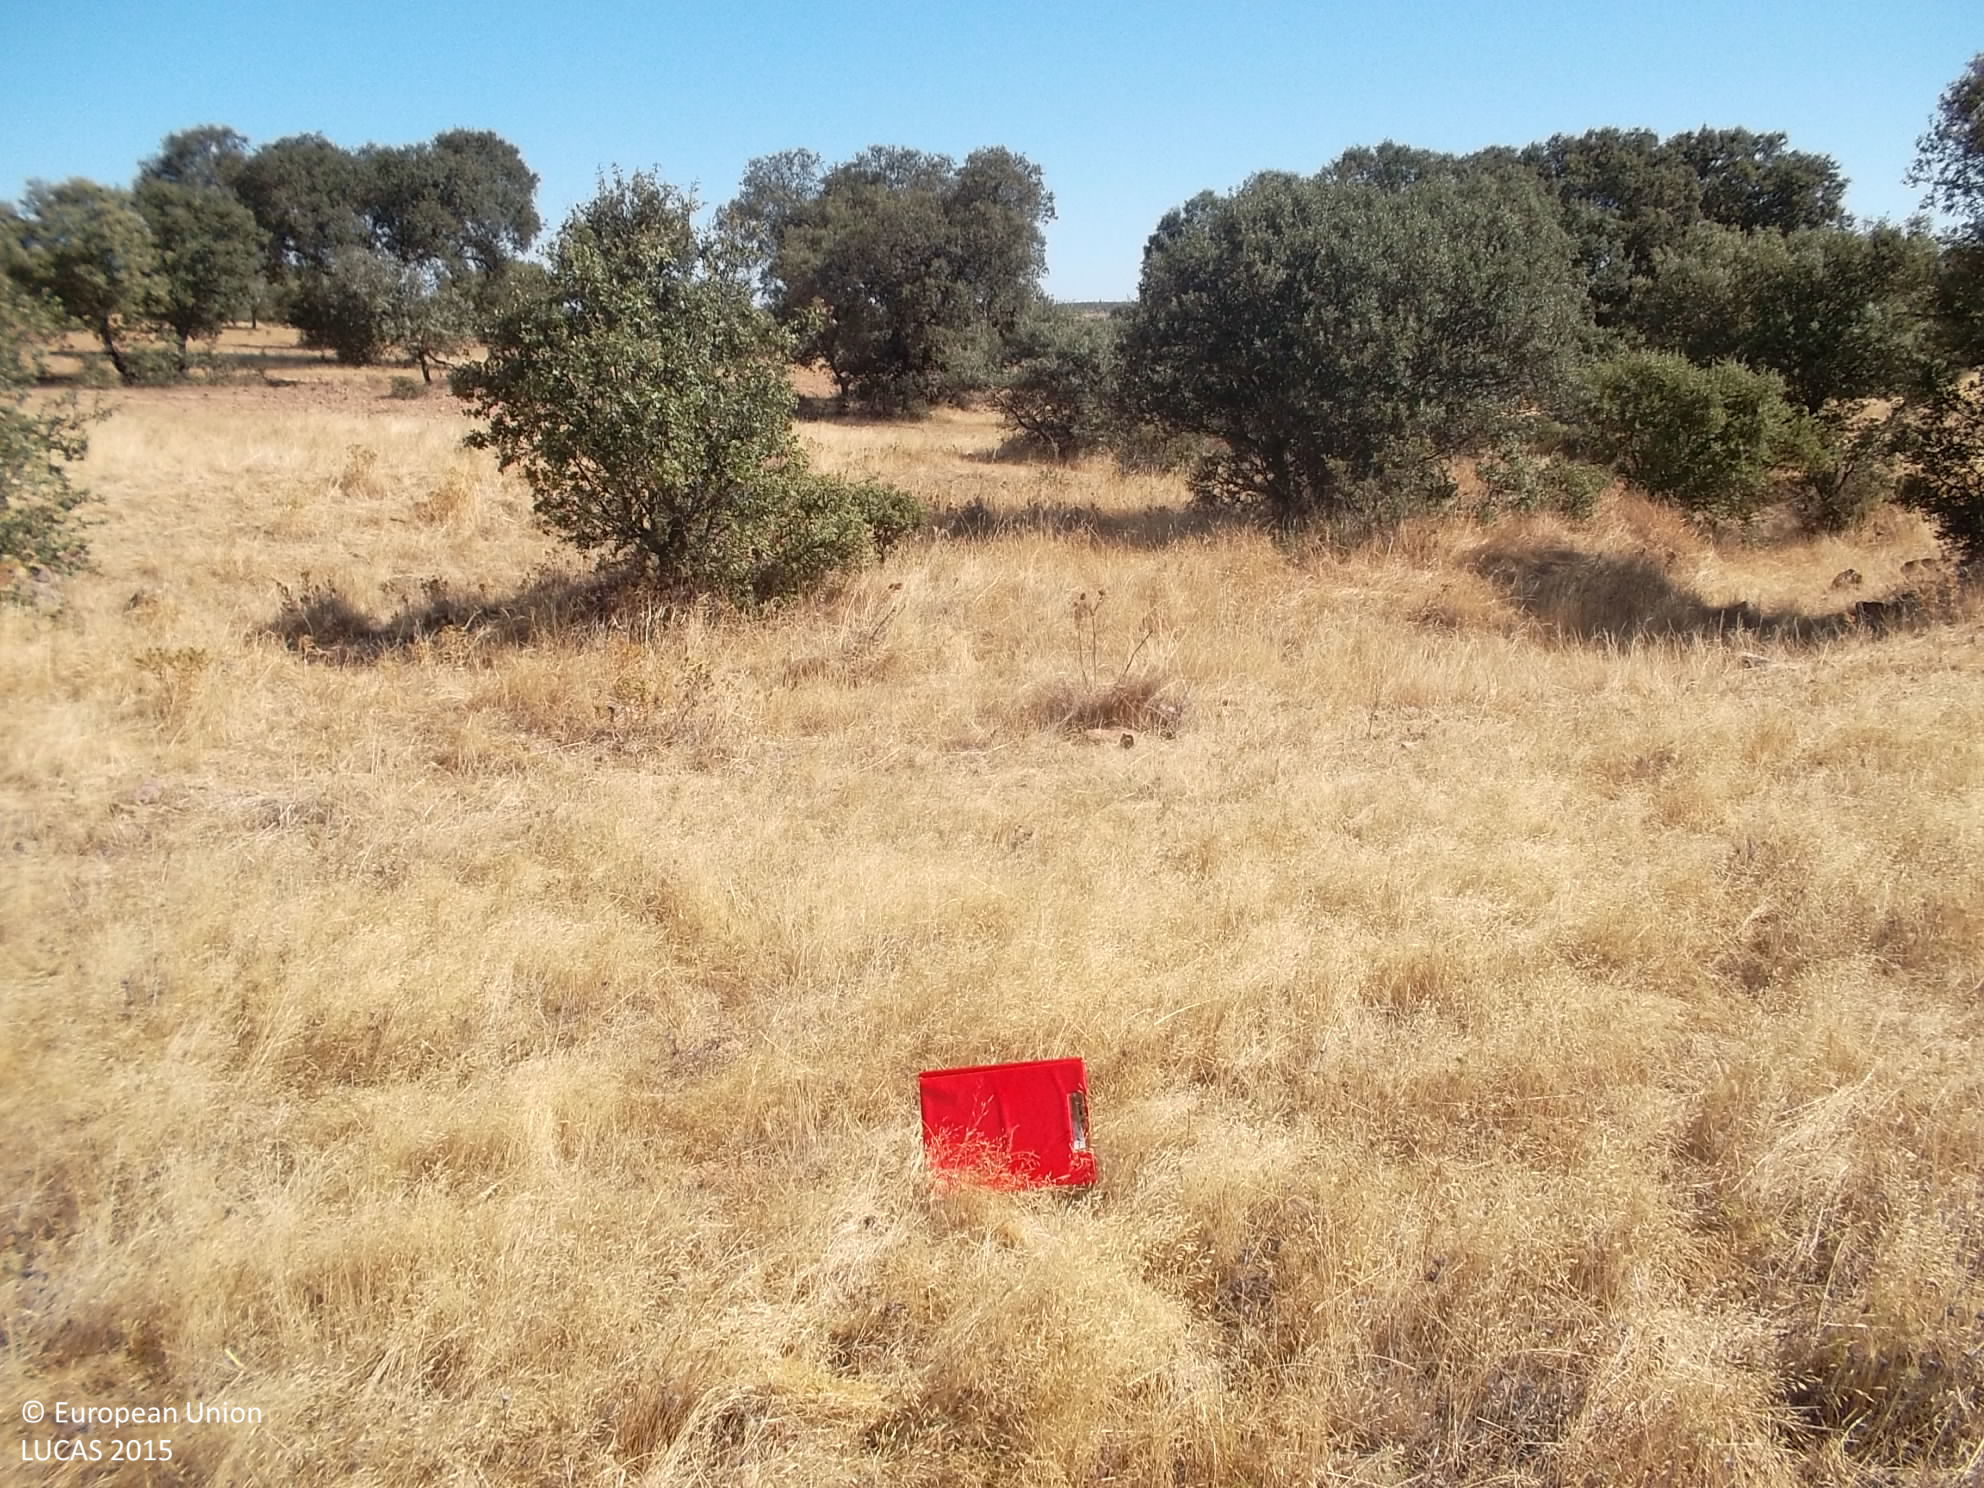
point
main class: Grassland
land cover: Grassland with sparse tree/shrub cover
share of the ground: > 75 %
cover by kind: herbaceous plants 90 %, broadleaved forest trees 5 %, shrubs 5 %
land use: Agriculture (excluding fallow land and kitchen gardens)
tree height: < 5 m
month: July
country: ES
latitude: 38.4555
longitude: -5.8428
